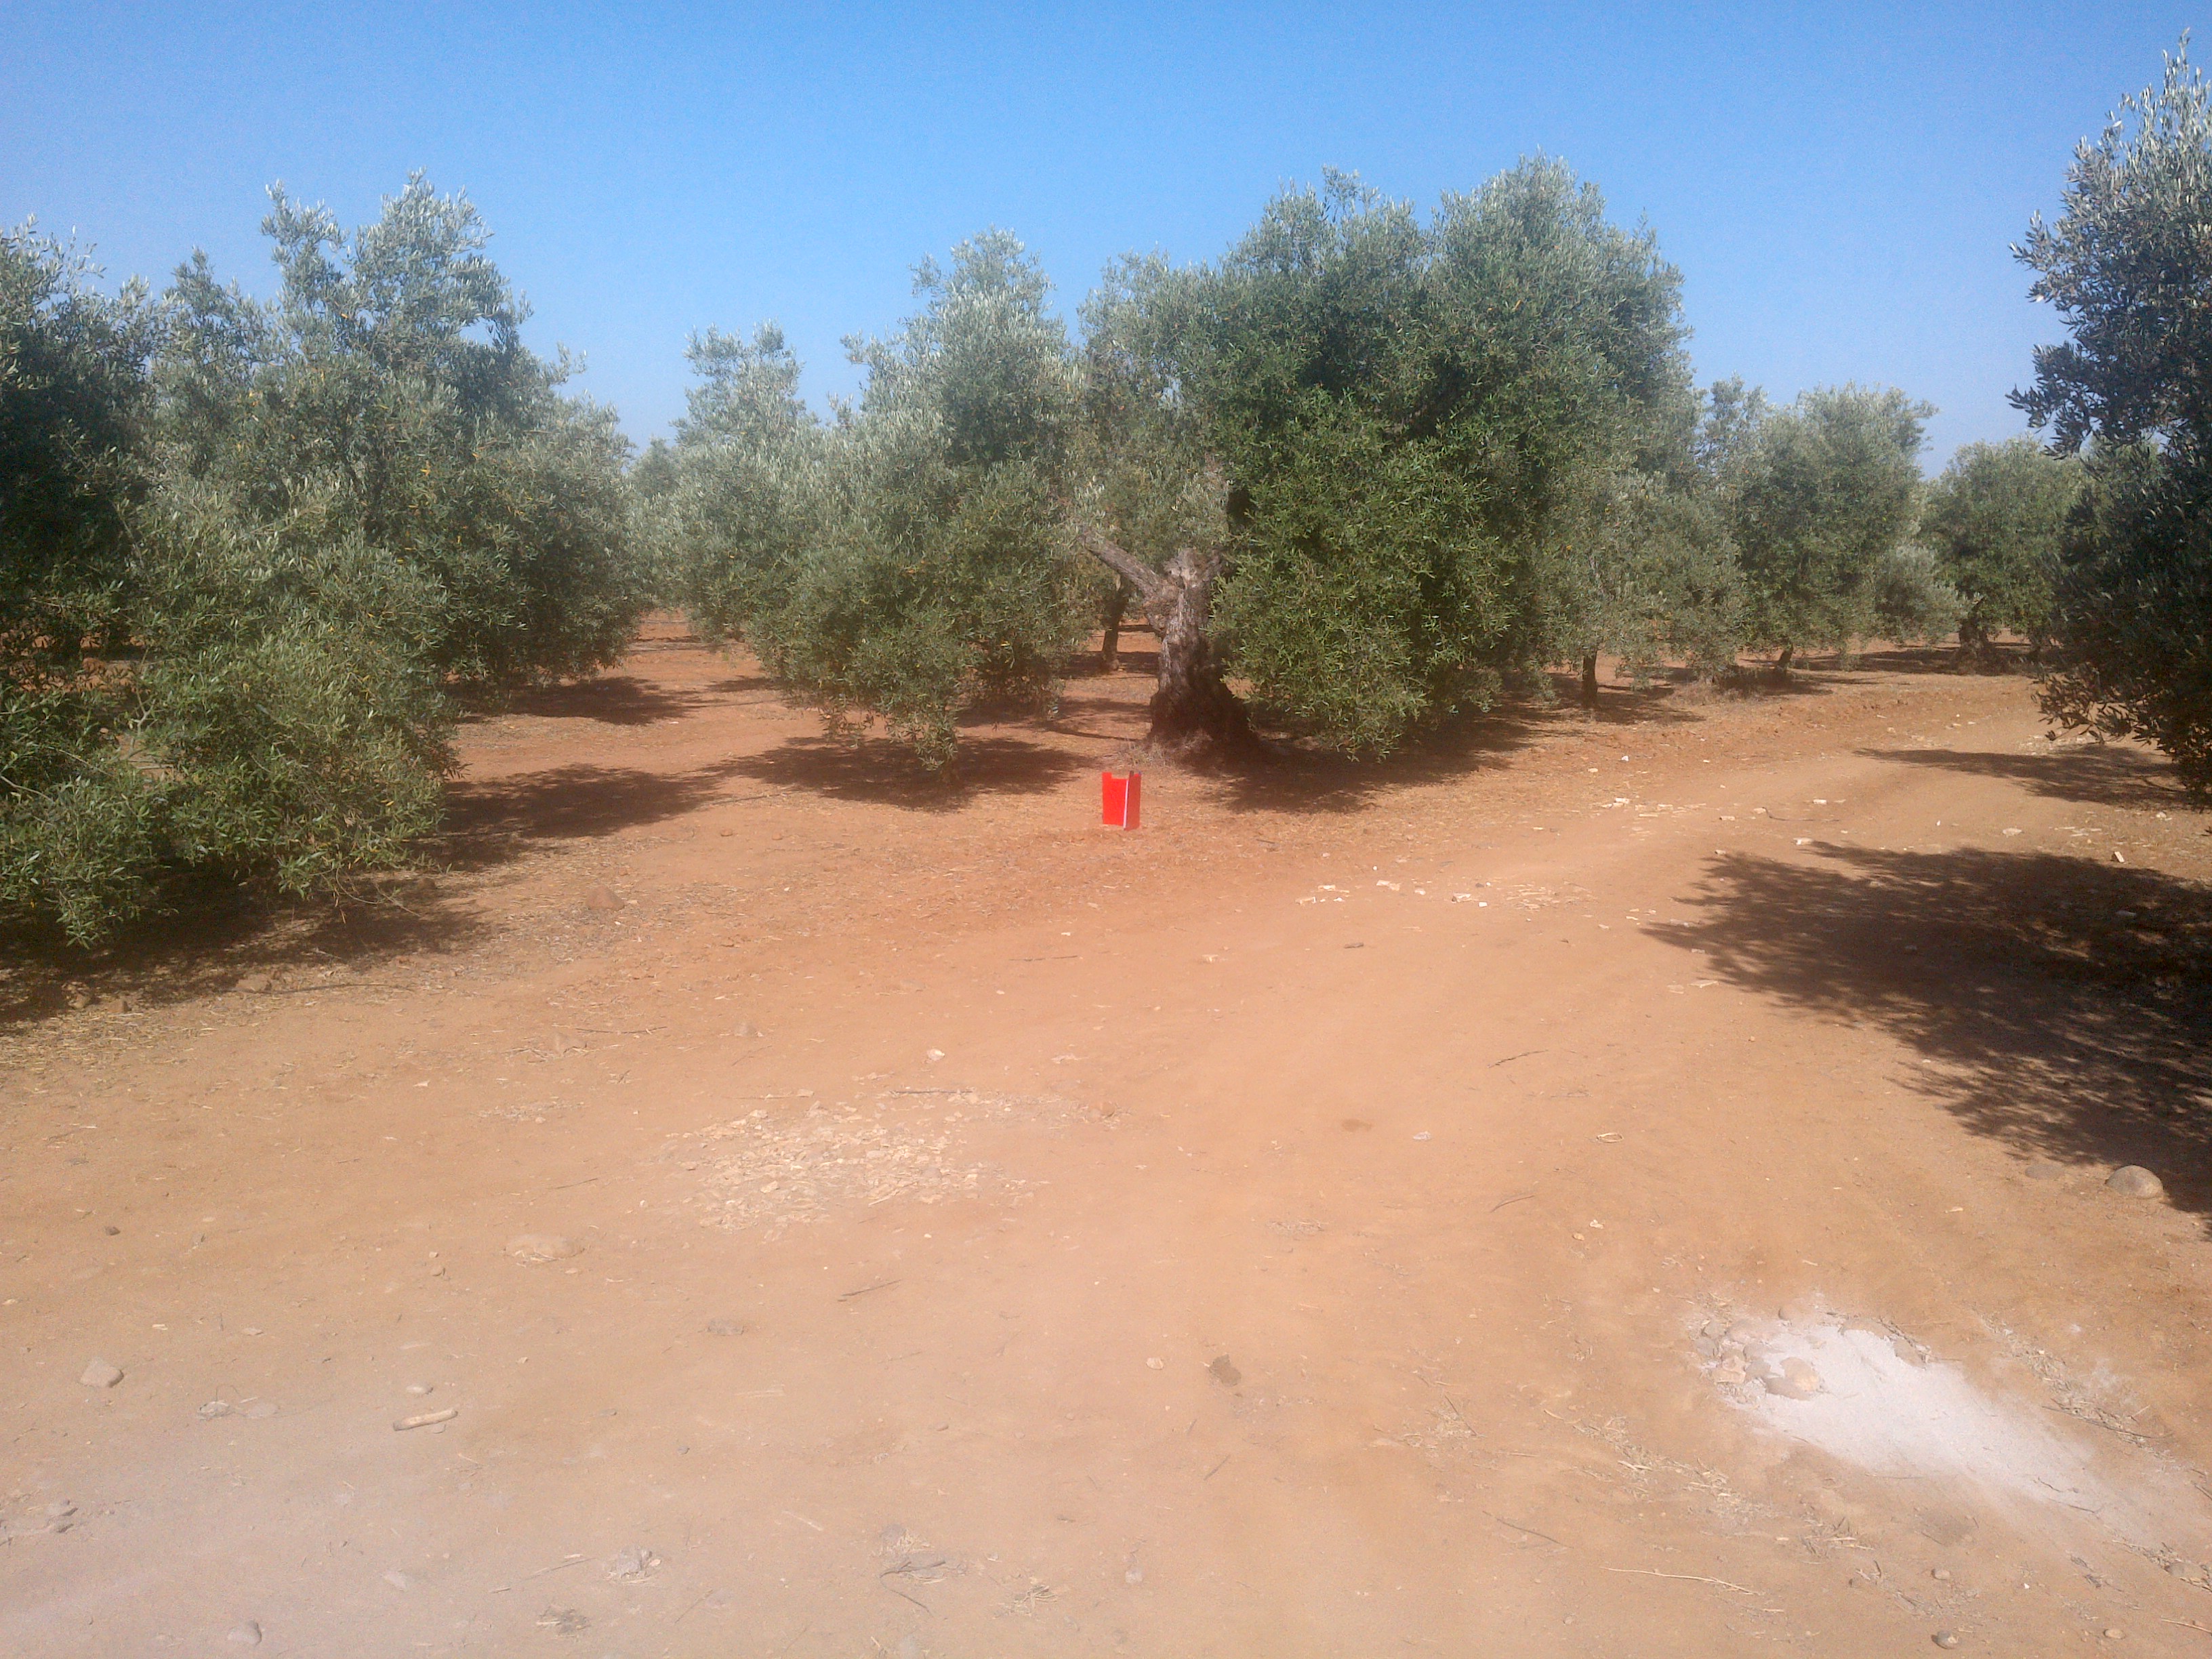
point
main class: Cropland
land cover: Olive groves
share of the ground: 50 - 75 %
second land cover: Other bare soil
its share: > 75 %
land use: Agriculture (excluding fallow land and kitchen gardens)
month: June
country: ES
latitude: 37.6814
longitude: -5.1767
